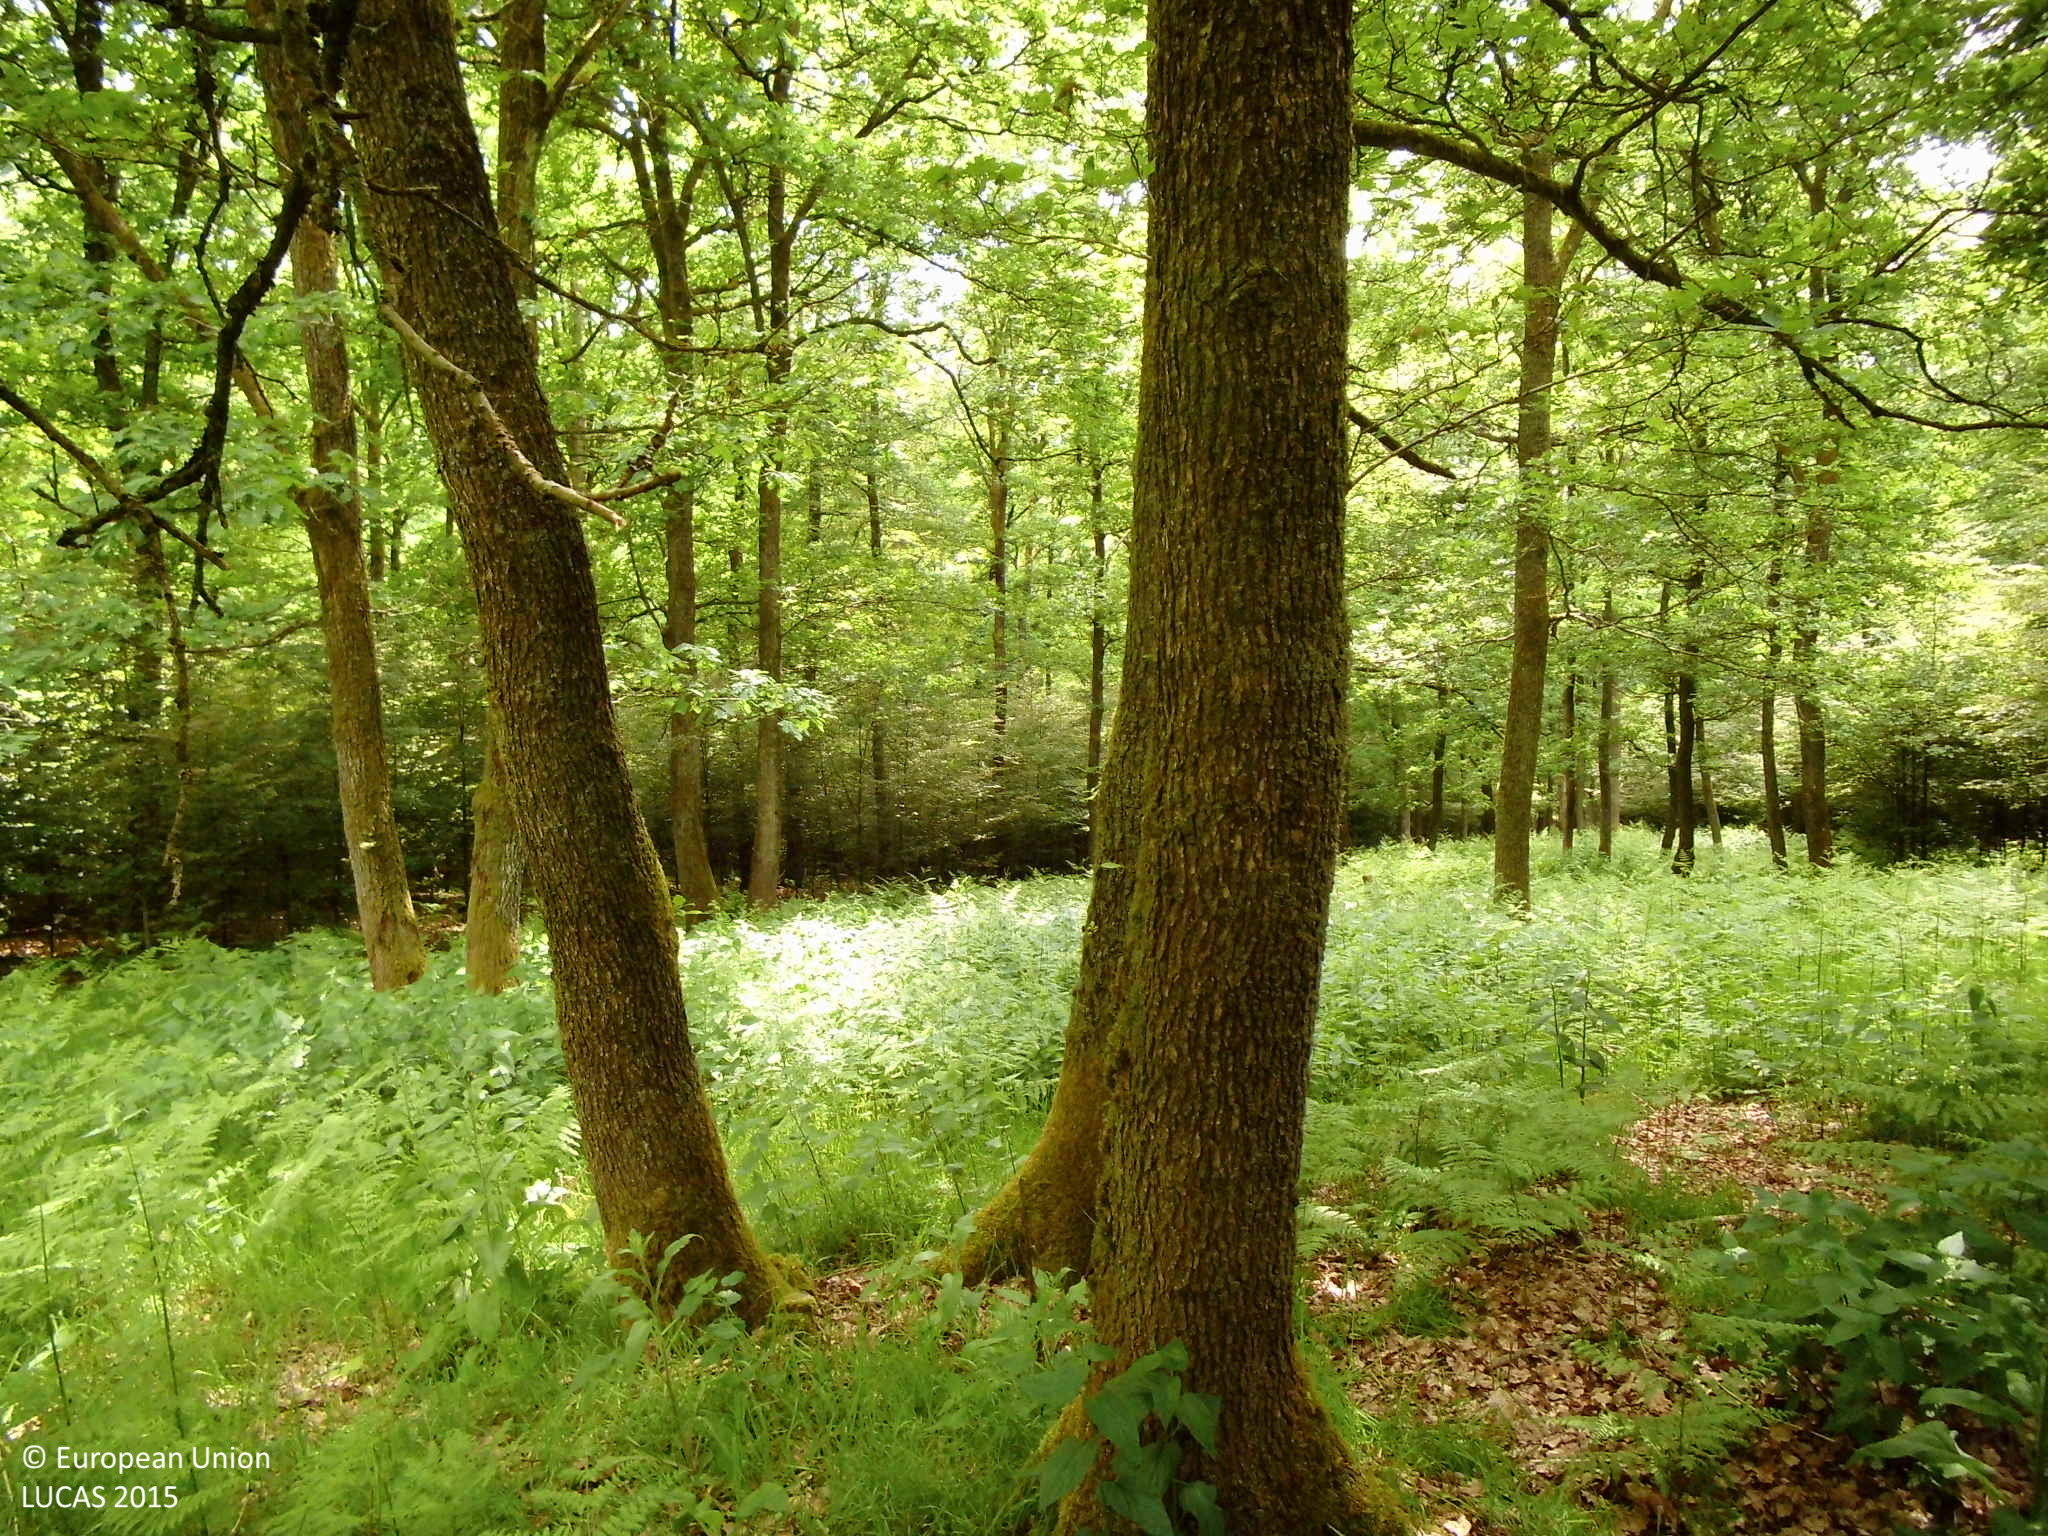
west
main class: Woodland
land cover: Broadleaved woodland
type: mesophytic deciduous forest
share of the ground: > 75 %
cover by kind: broadleaved forest trees 80 %, herbaceous plants 20 %
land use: Forestry
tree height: > 5 m
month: June
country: DE
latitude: 50.7981
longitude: 8.1133
